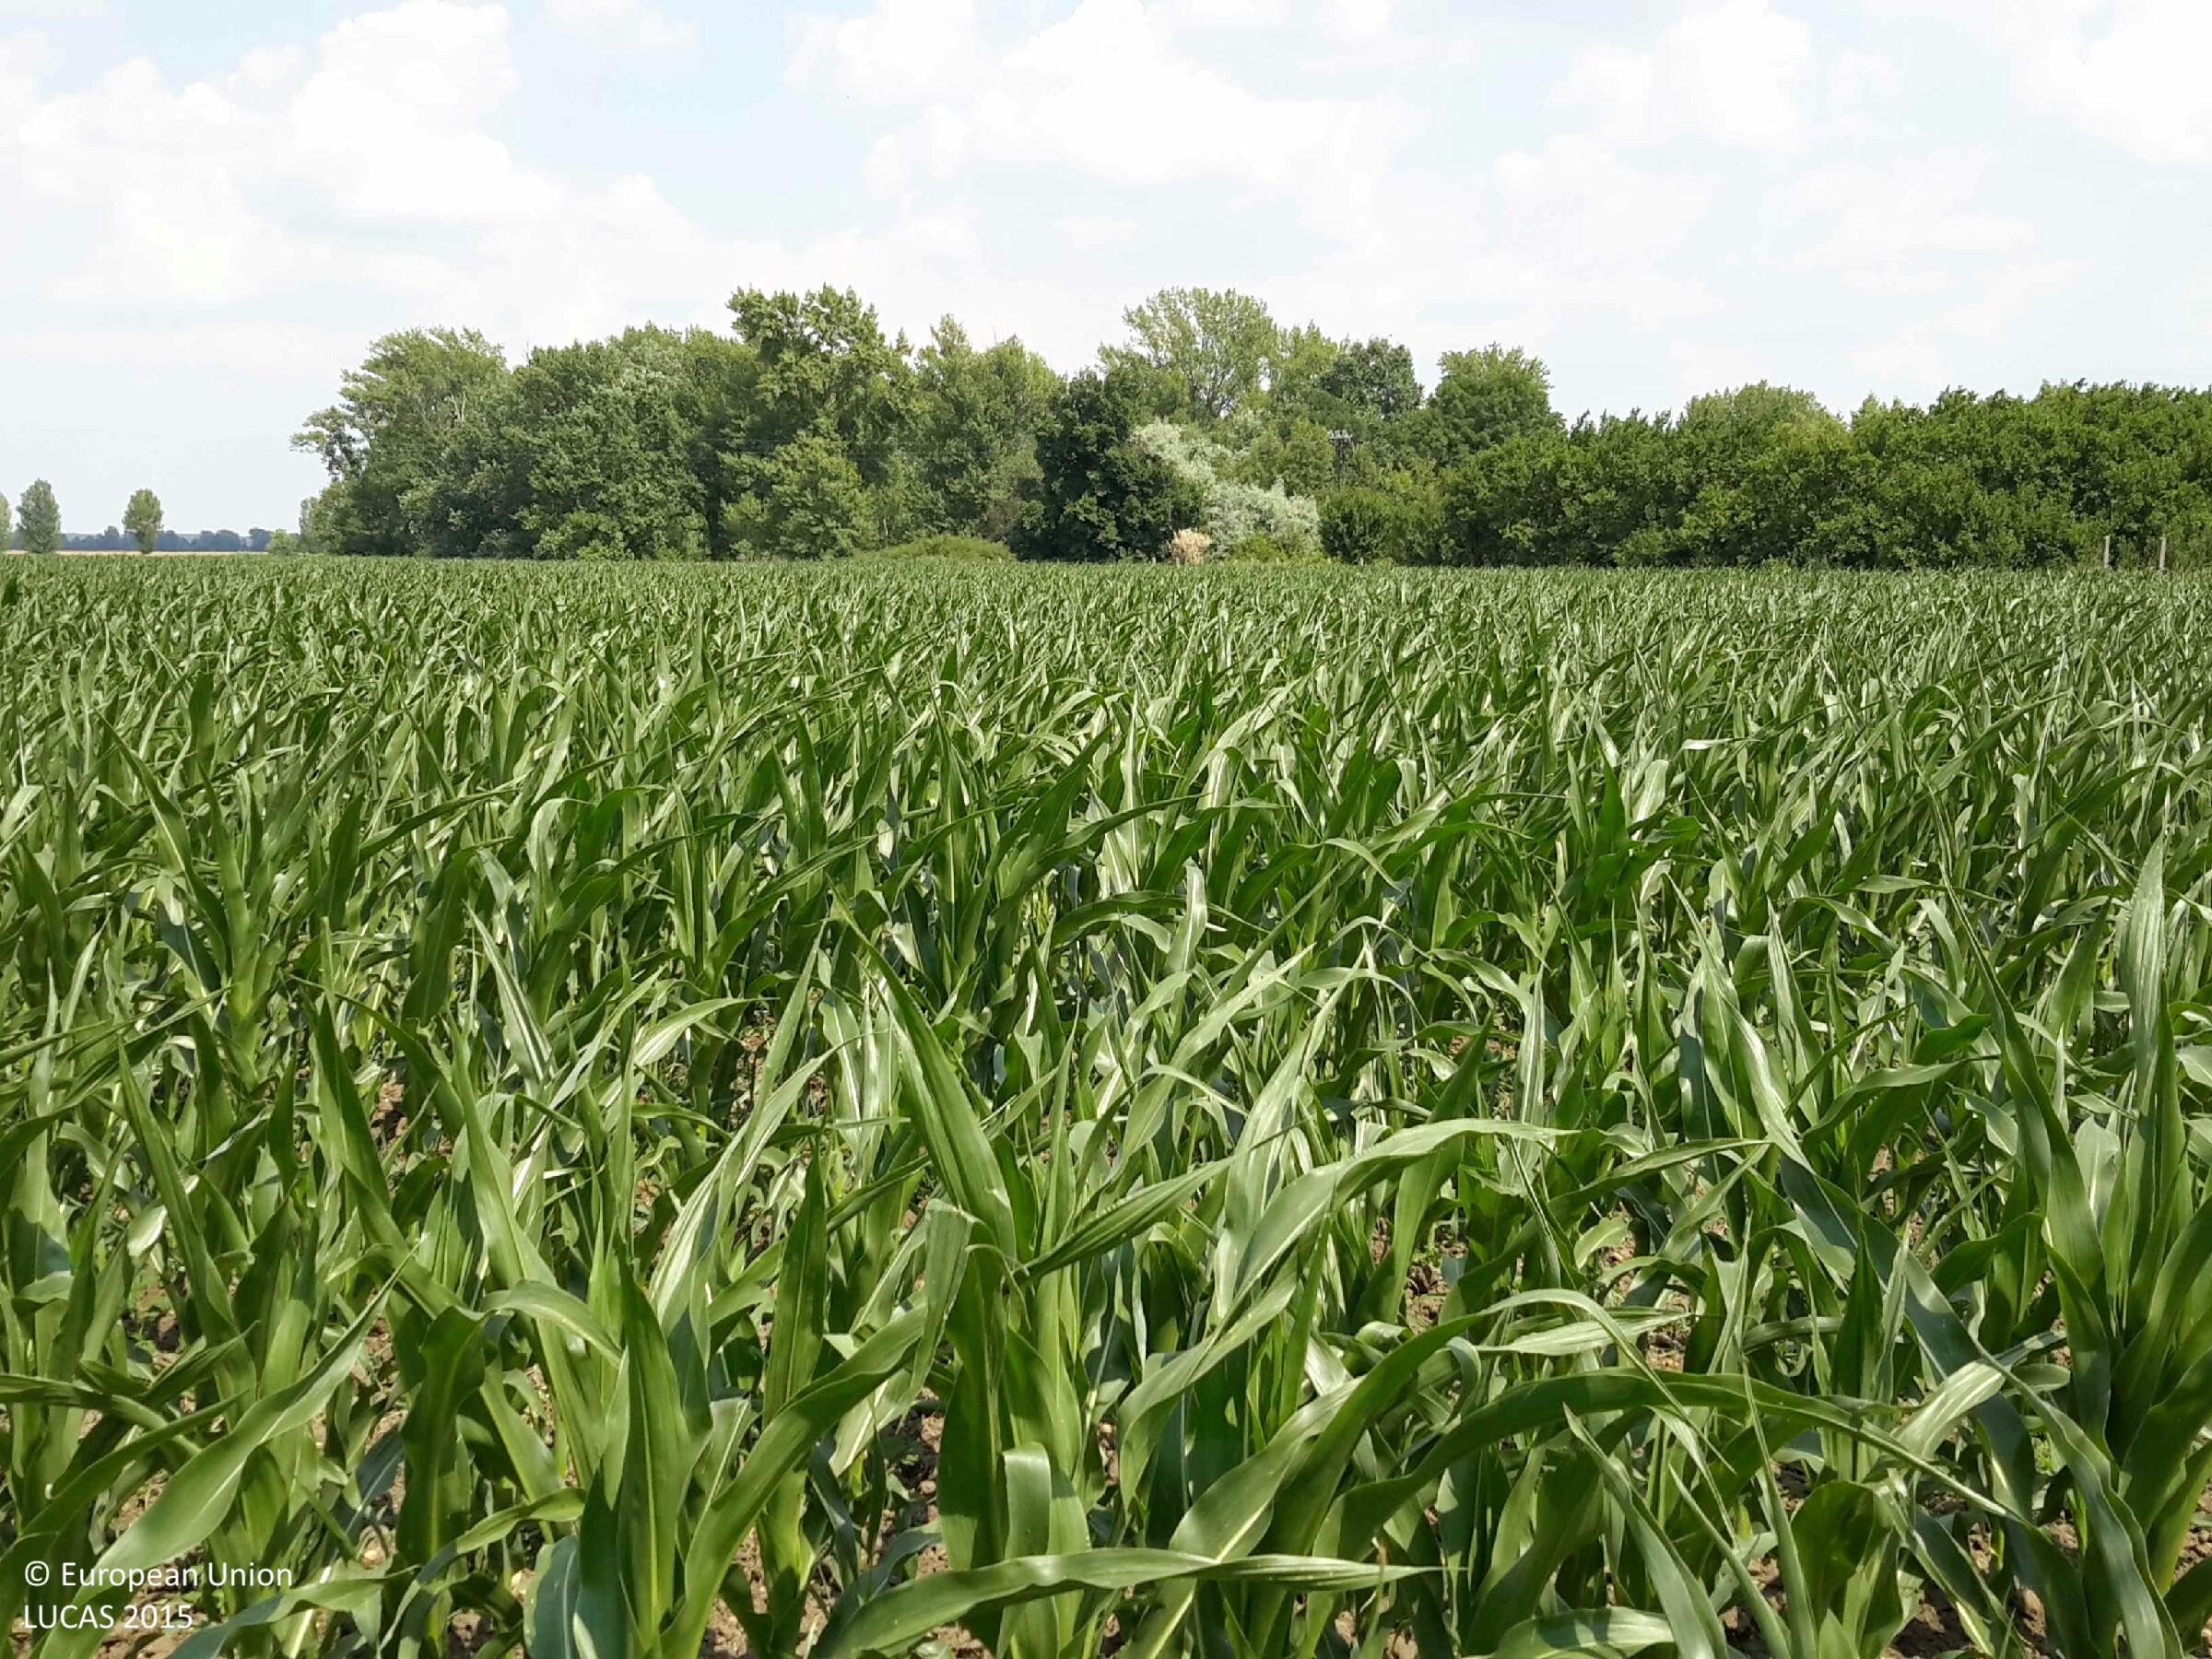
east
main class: Cropland
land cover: Maize
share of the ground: 50 - 75 %
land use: Agriculture (excluding fallow land and kitchen gardens)
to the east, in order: Maize; Grass margins; Fences; Spontaneously vegetated surfaces; Broadleaved woodland
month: July
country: HU
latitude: 47.3615
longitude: 17.3820
